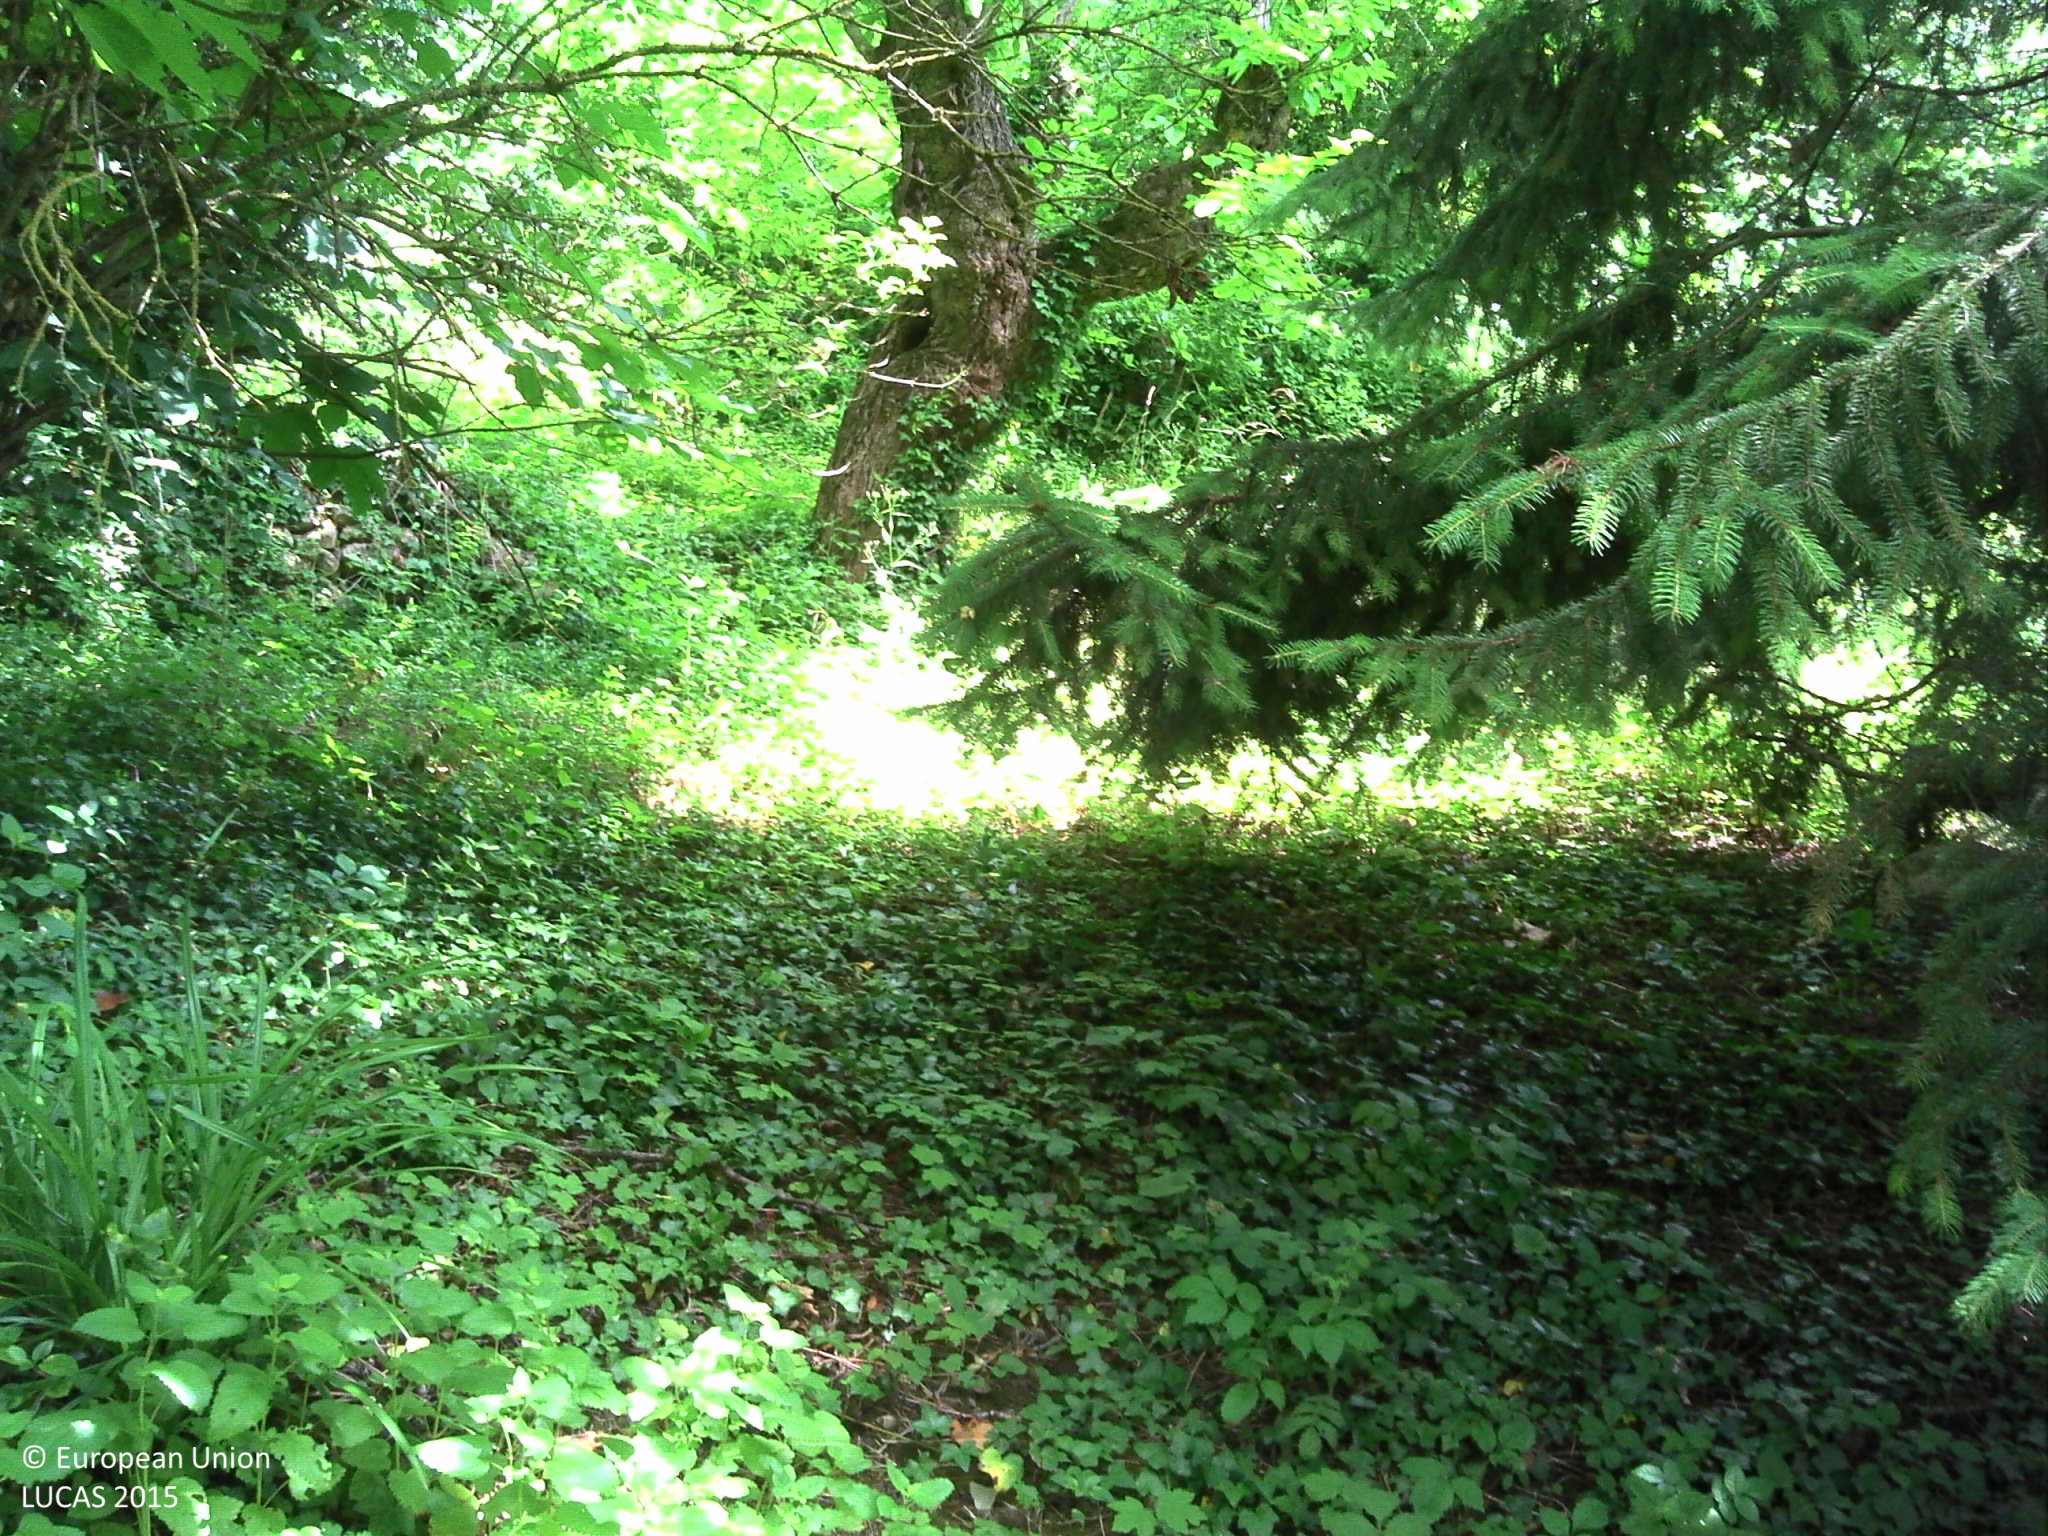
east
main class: Woodland
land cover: Broadleaved woodland
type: mesophytic deciduous forest
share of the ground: > 75 %
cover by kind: broadleaved forest trees 70 %, coniferous forest trees 10 %, shrubs 10 %, herbaceous plants 10 %
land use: Semi-natural and natural areas not in use
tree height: > 5 m
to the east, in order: Broadleaved woodland; Artificial constructions in urban areas; Broadleaved woodland; Electric lines; Tracks; Grass margins; Grassland with sparse tree/shrub cover; Fences; Shrubland without tree cover; Grassland without tree/shrub cover; Broadleaved woodland; Grassland with sparse tree/shrub cover; Broadleaved woodland
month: June
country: FR
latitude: 44.7379
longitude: 5.0434
